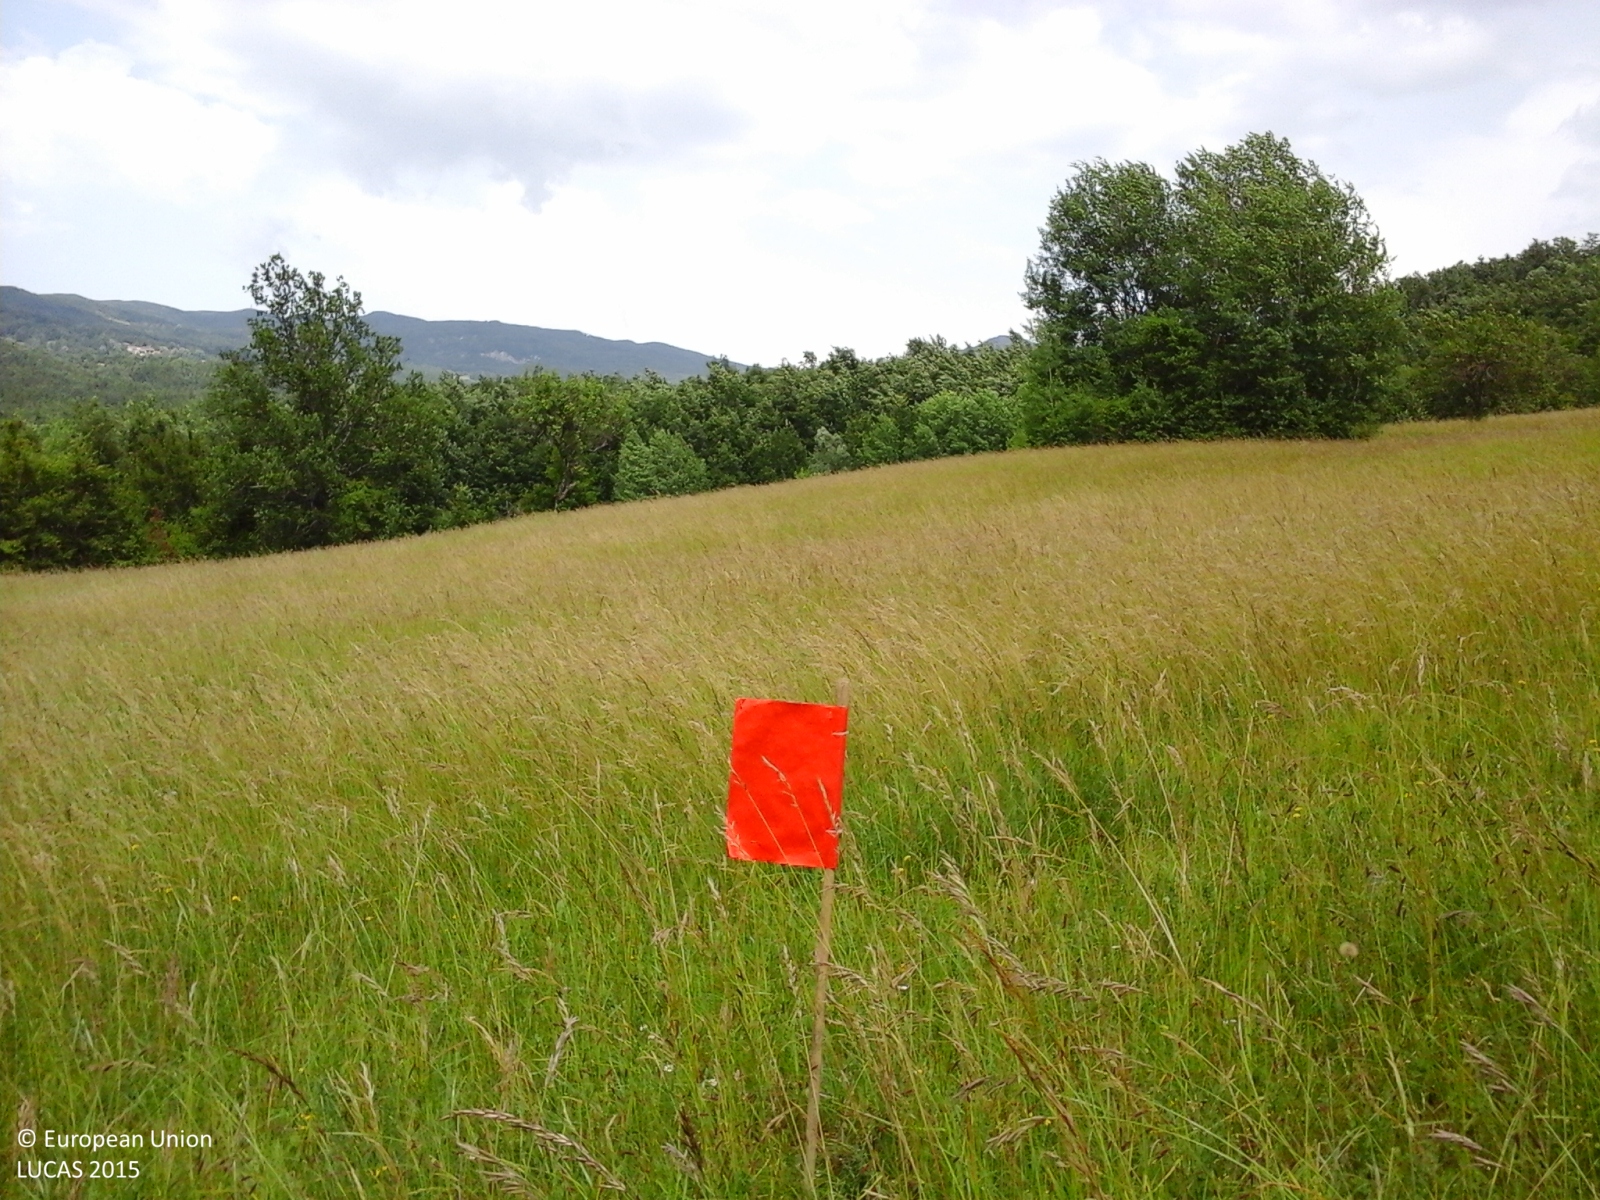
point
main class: Grassland
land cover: Grassland without tree/shrub cover
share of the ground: > 75 %
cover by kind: herbaceous plants 100 %
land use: Agriculture (excluding fallow land and kitchen gardens)
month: June
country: IT
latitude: 44.6744
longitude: 9.6098
